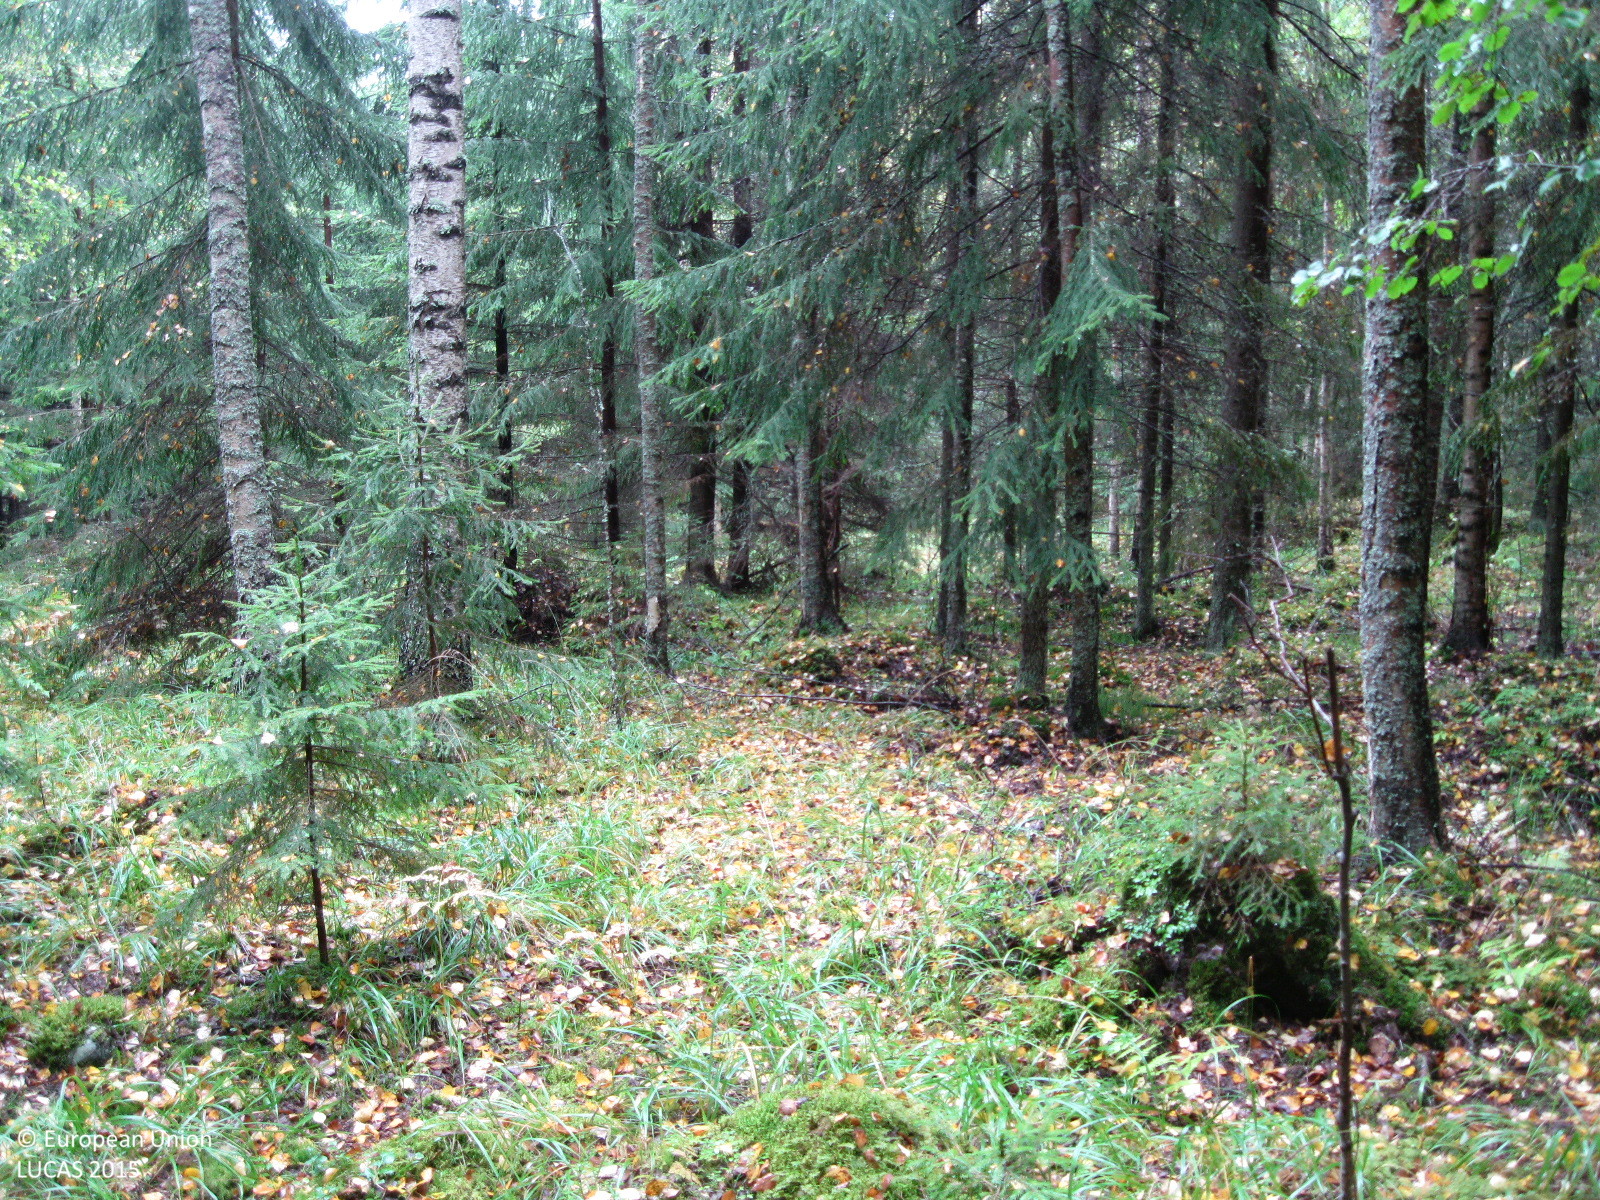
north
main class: Woodland
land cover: Spruce dominated coniferous woodland
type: boreal forest
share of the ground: > 75 %
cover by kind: coniferous forest trees 60 %, broadleaved forest trees 15 %, herbaceous plants 15 %, lichens and mosses 10 %
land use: Forestry
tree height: > 5 m
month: September
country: FI
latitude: 60.8309
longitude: 24.5810
